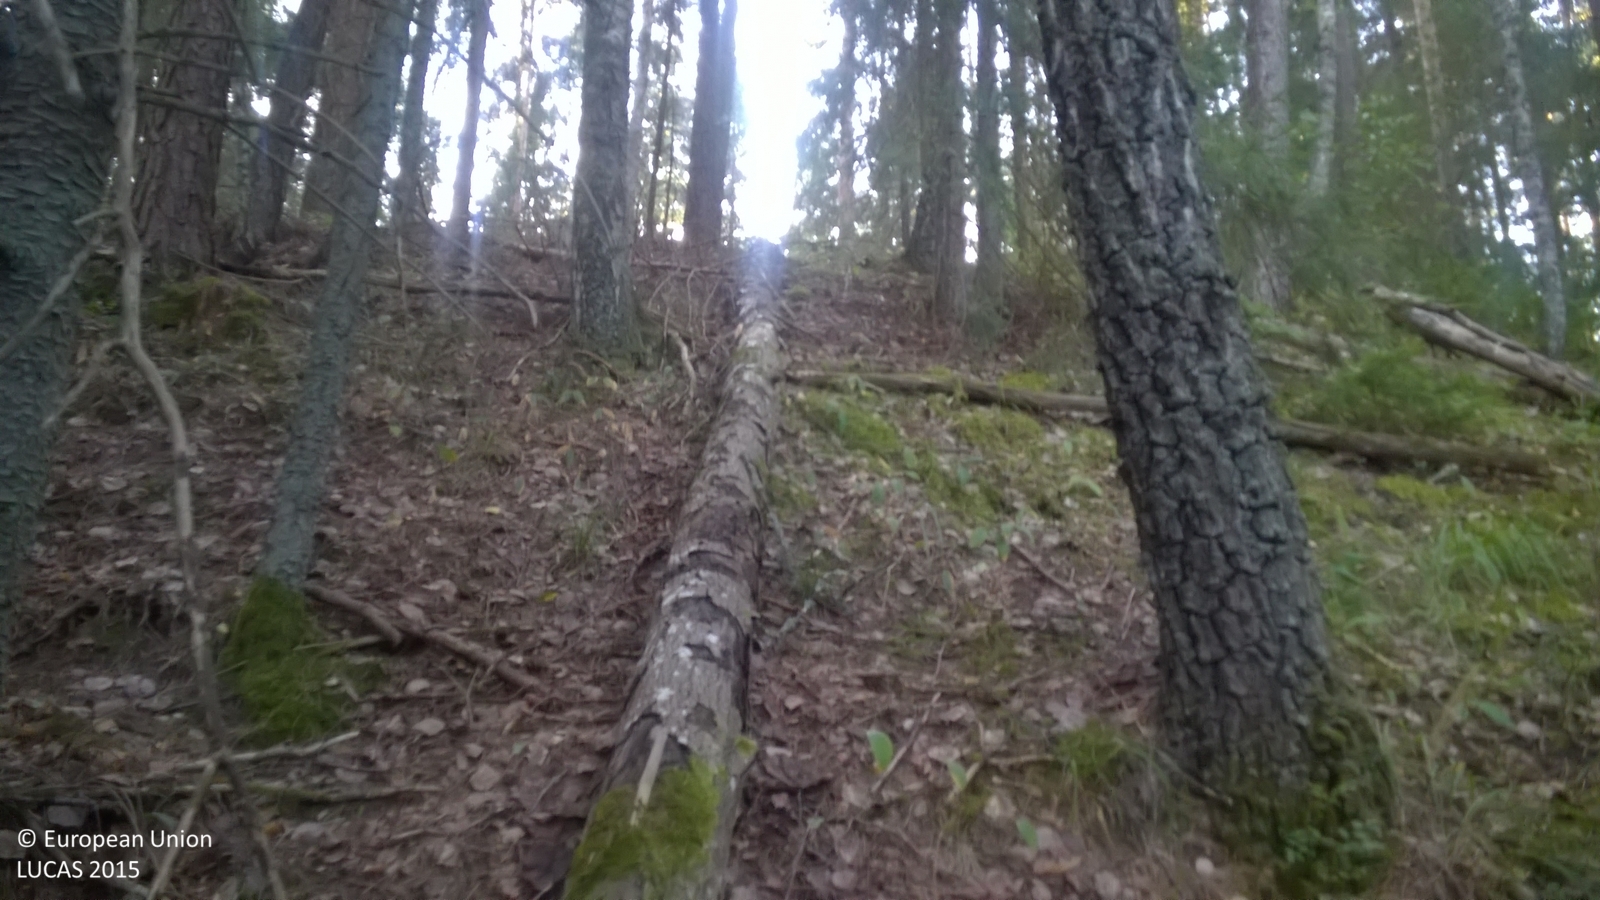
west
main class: Woodland
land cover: Other mixed woodland
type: hemiboreal forest and nemoral coniferous forest and mixed broadleaved-coniferous forest
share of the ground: > 75 %
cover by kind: coniferous forest trees 50 %, broadleaved forest trees 35 %, herbaceous plants 5 %, lichens and mosses 5 %, unconsolidated bare surface 5 %
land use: Forestry
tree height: > 5 m
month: August
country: LV
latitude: 57.7046
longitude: 26.0541
